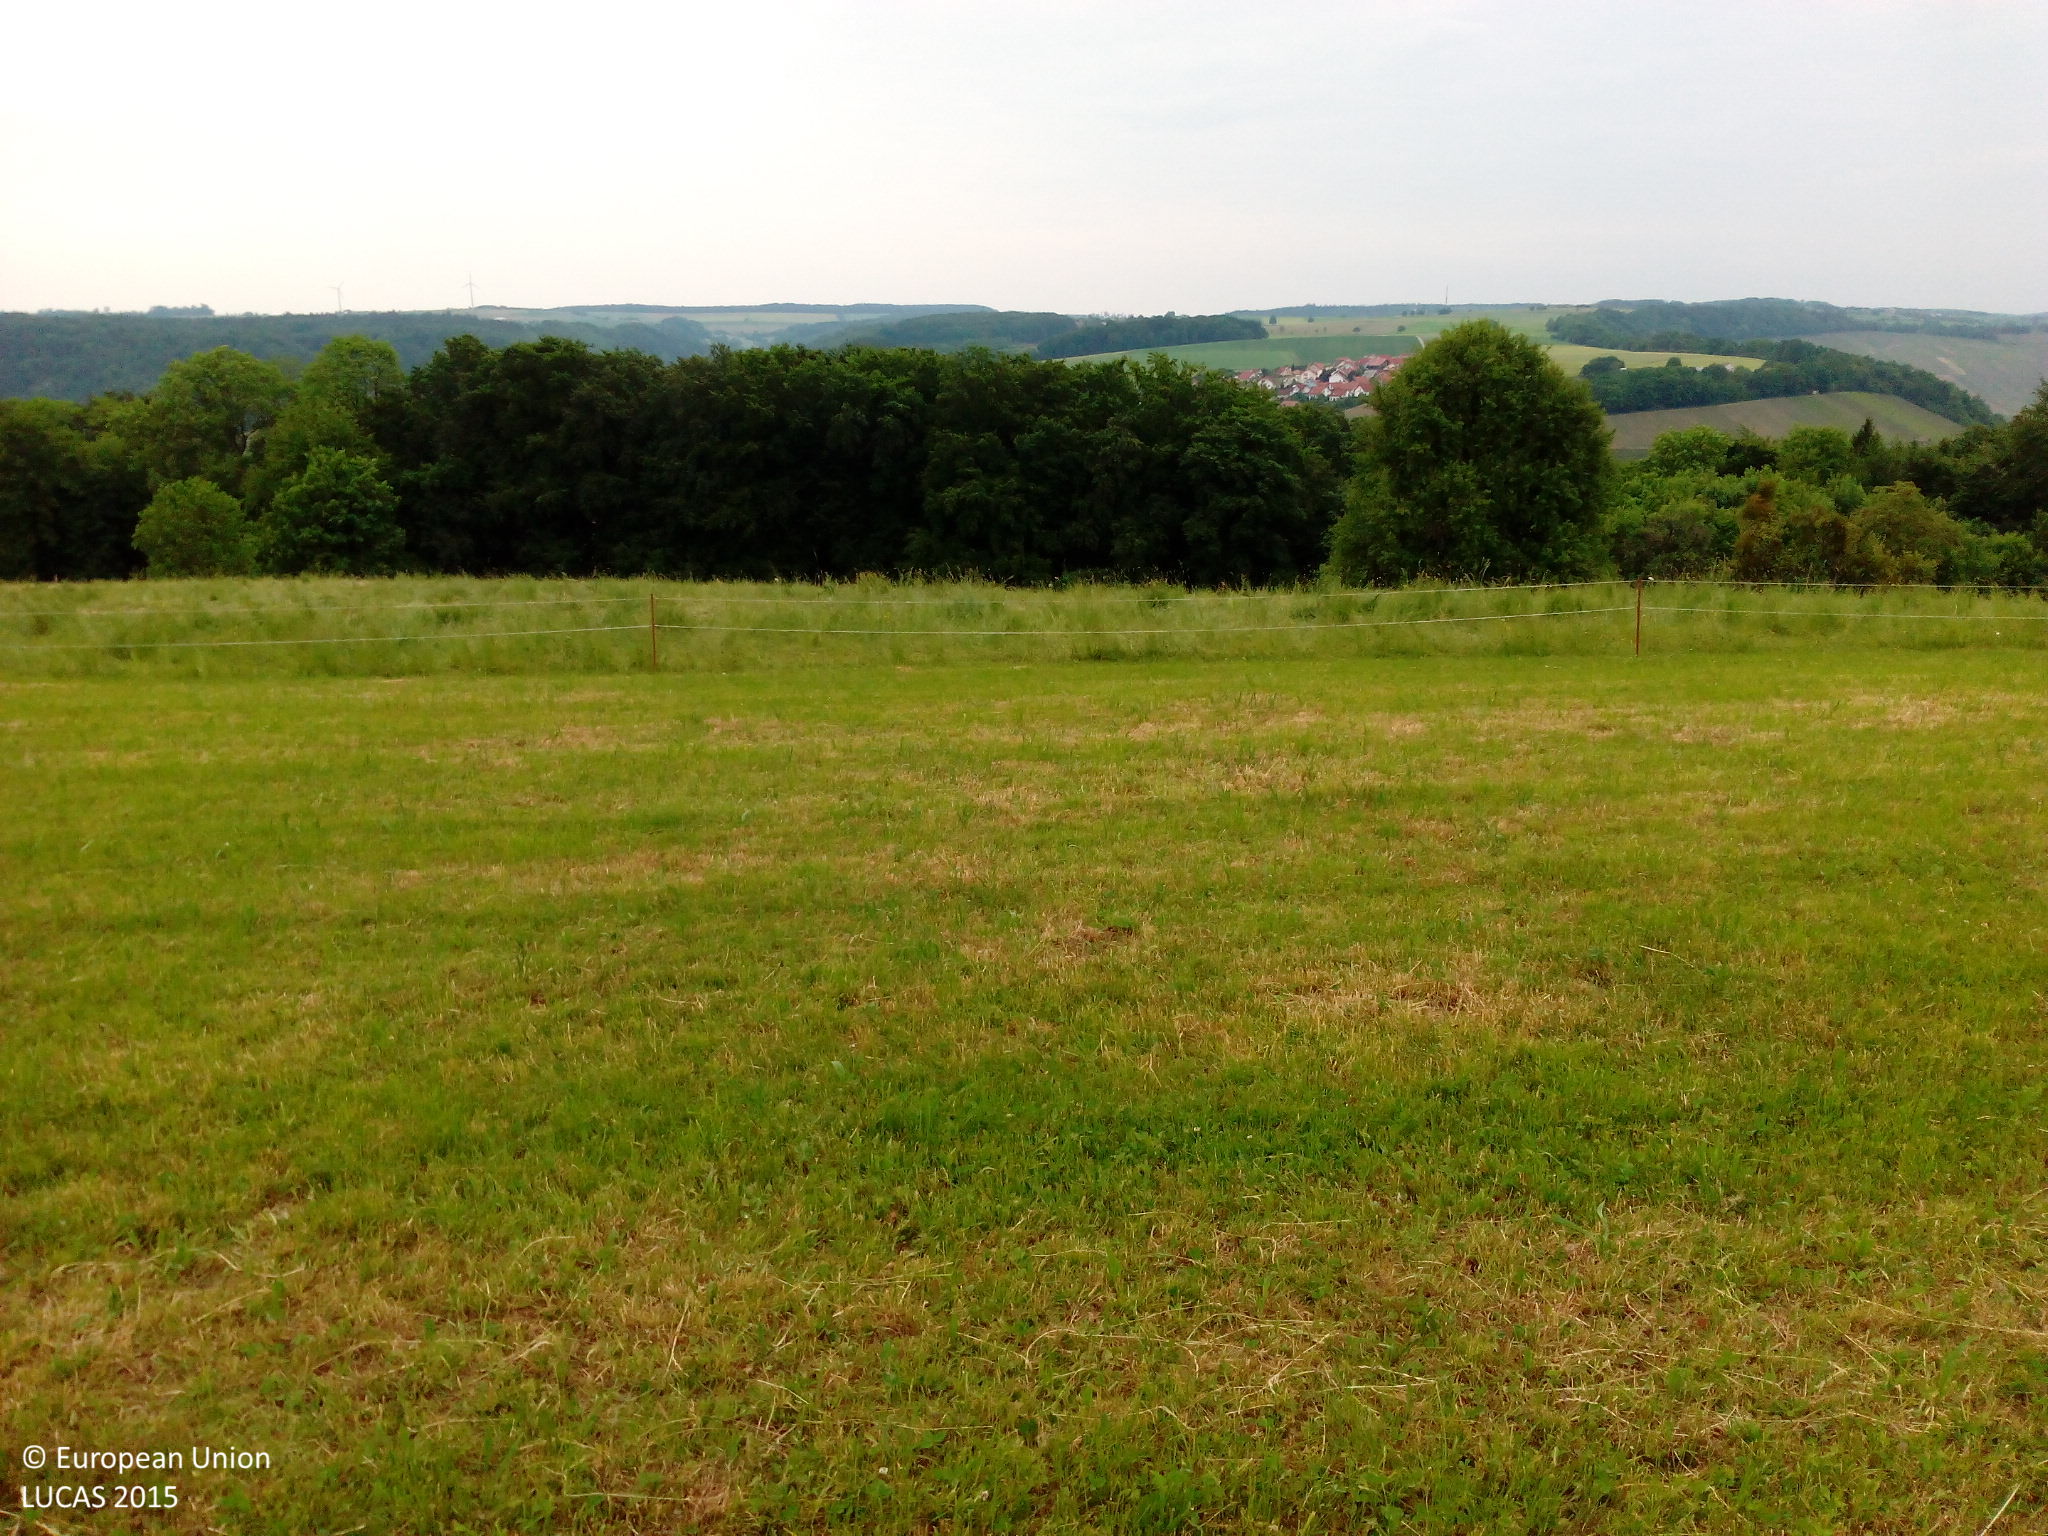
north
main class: Grassland
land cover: Grassland without tree/shrub cover
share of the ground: > 75 %
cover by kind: herbaceous plants 100 %
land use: Agriculture (excluding fallow land and kitchen gardens)
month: May
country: DE
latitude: 49.2843
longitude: 9.6015
